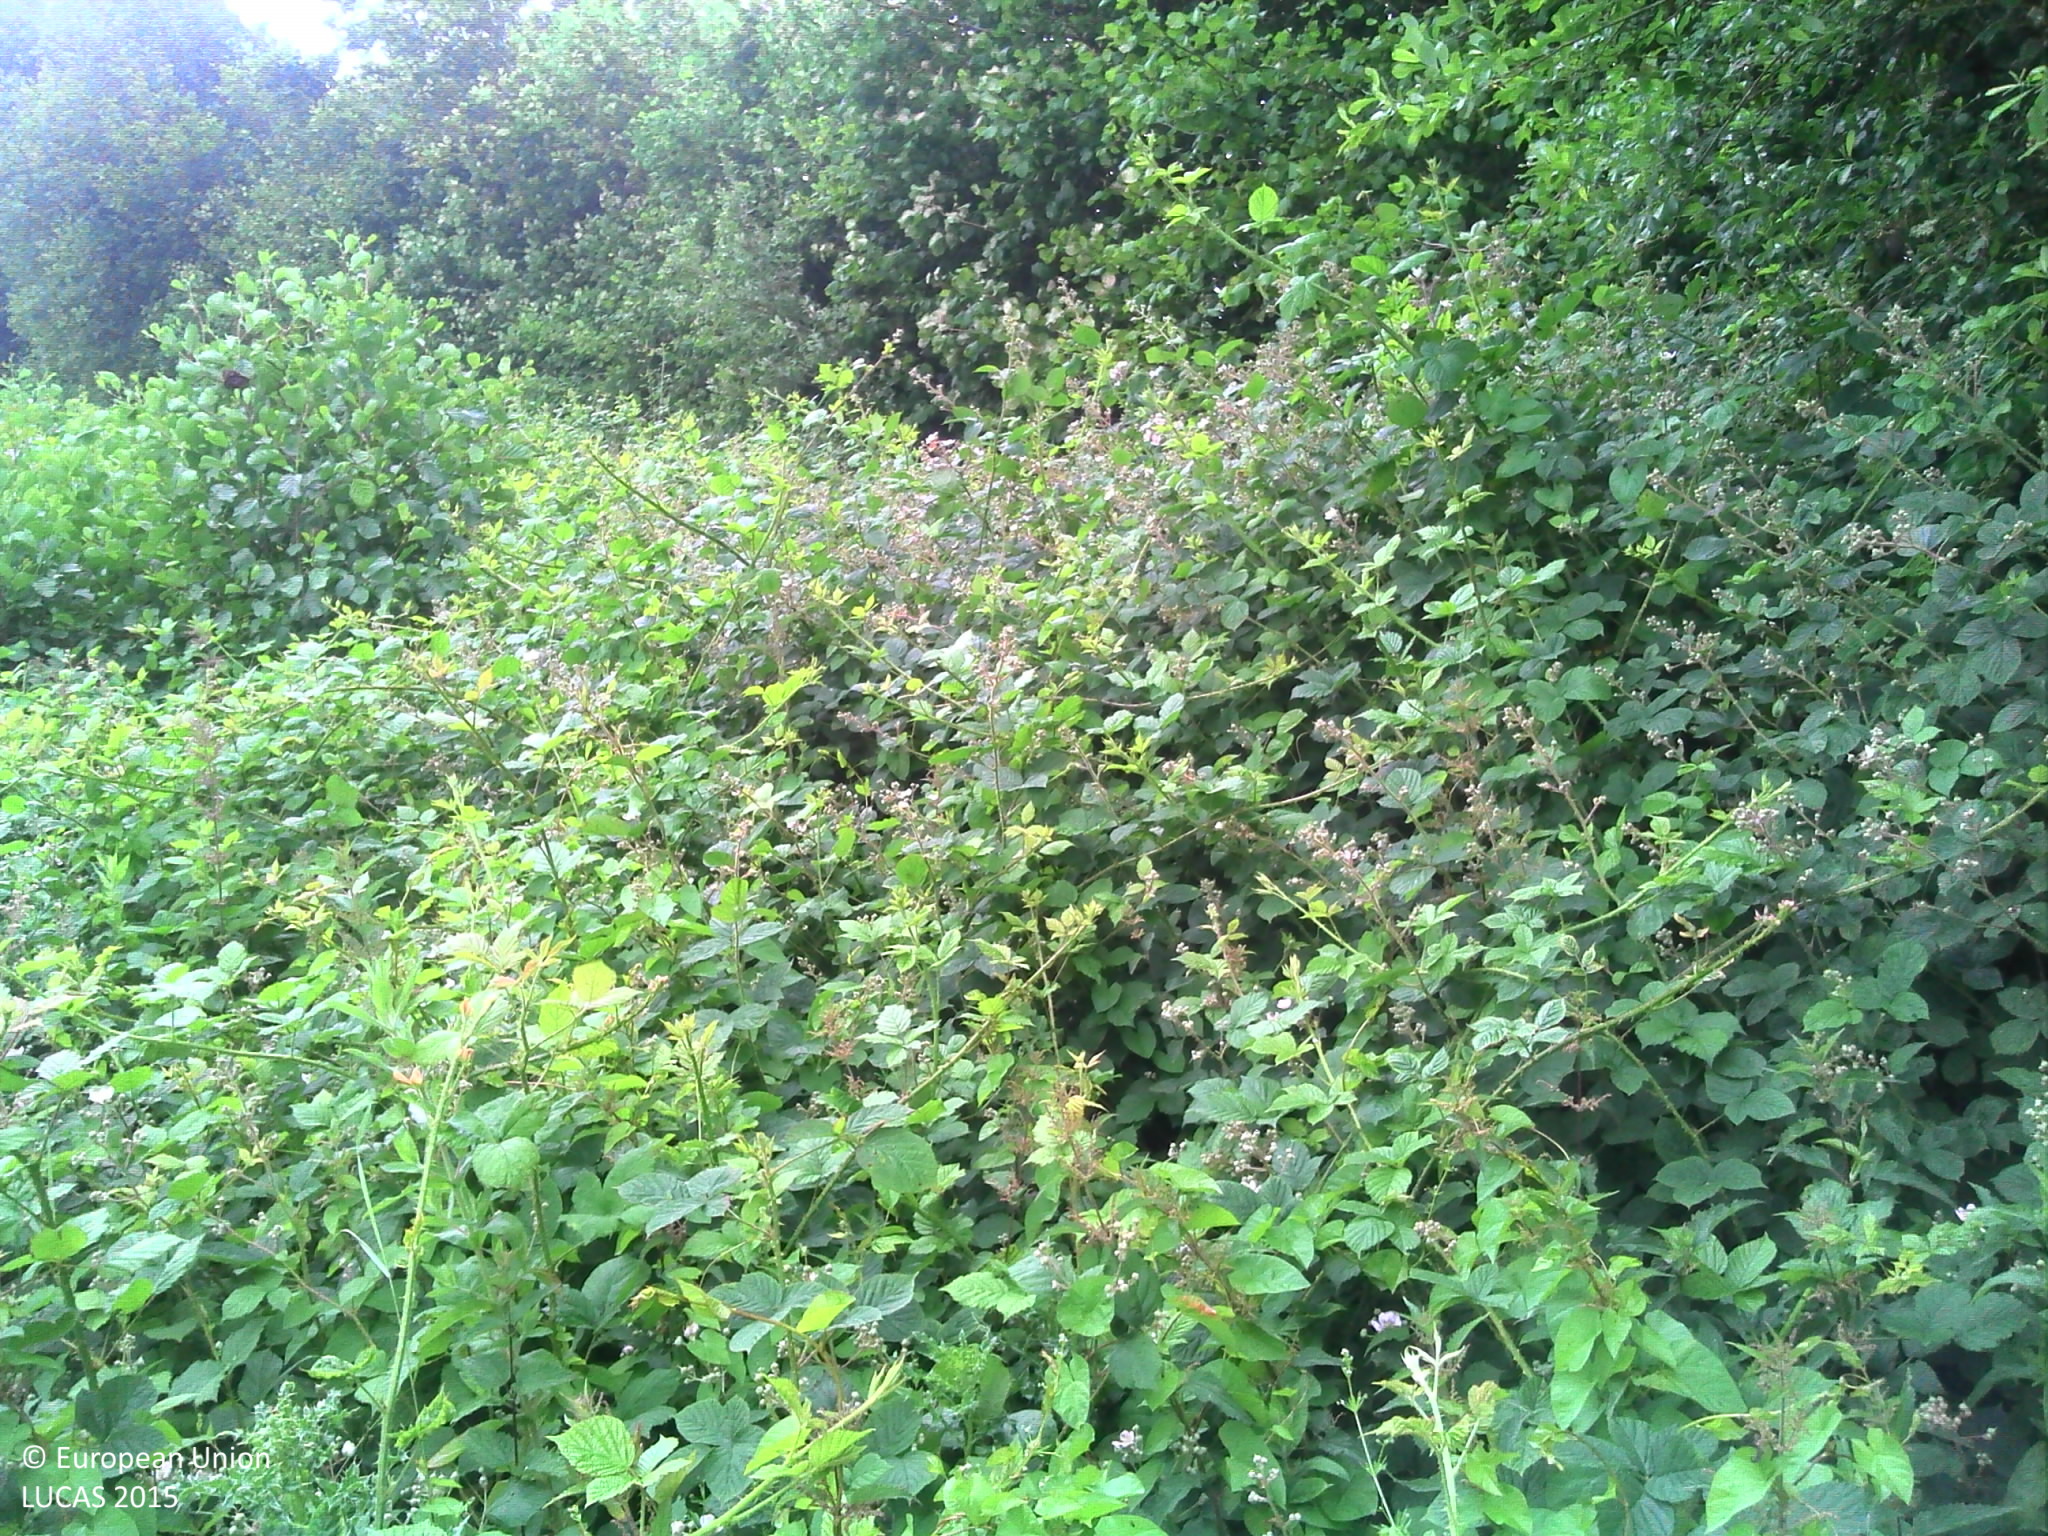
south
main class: Shrubland
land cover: Shrubland with sparse tree cover
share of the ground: > 75 %
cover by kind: shrubs 80 %, herbaceous plants 10 %, broadleaved forest trees 5 %
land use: Semi-natural and natural areas not in use
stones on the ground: < 10 %
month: June
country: FR
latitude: 48.7830
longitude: -0.1988
